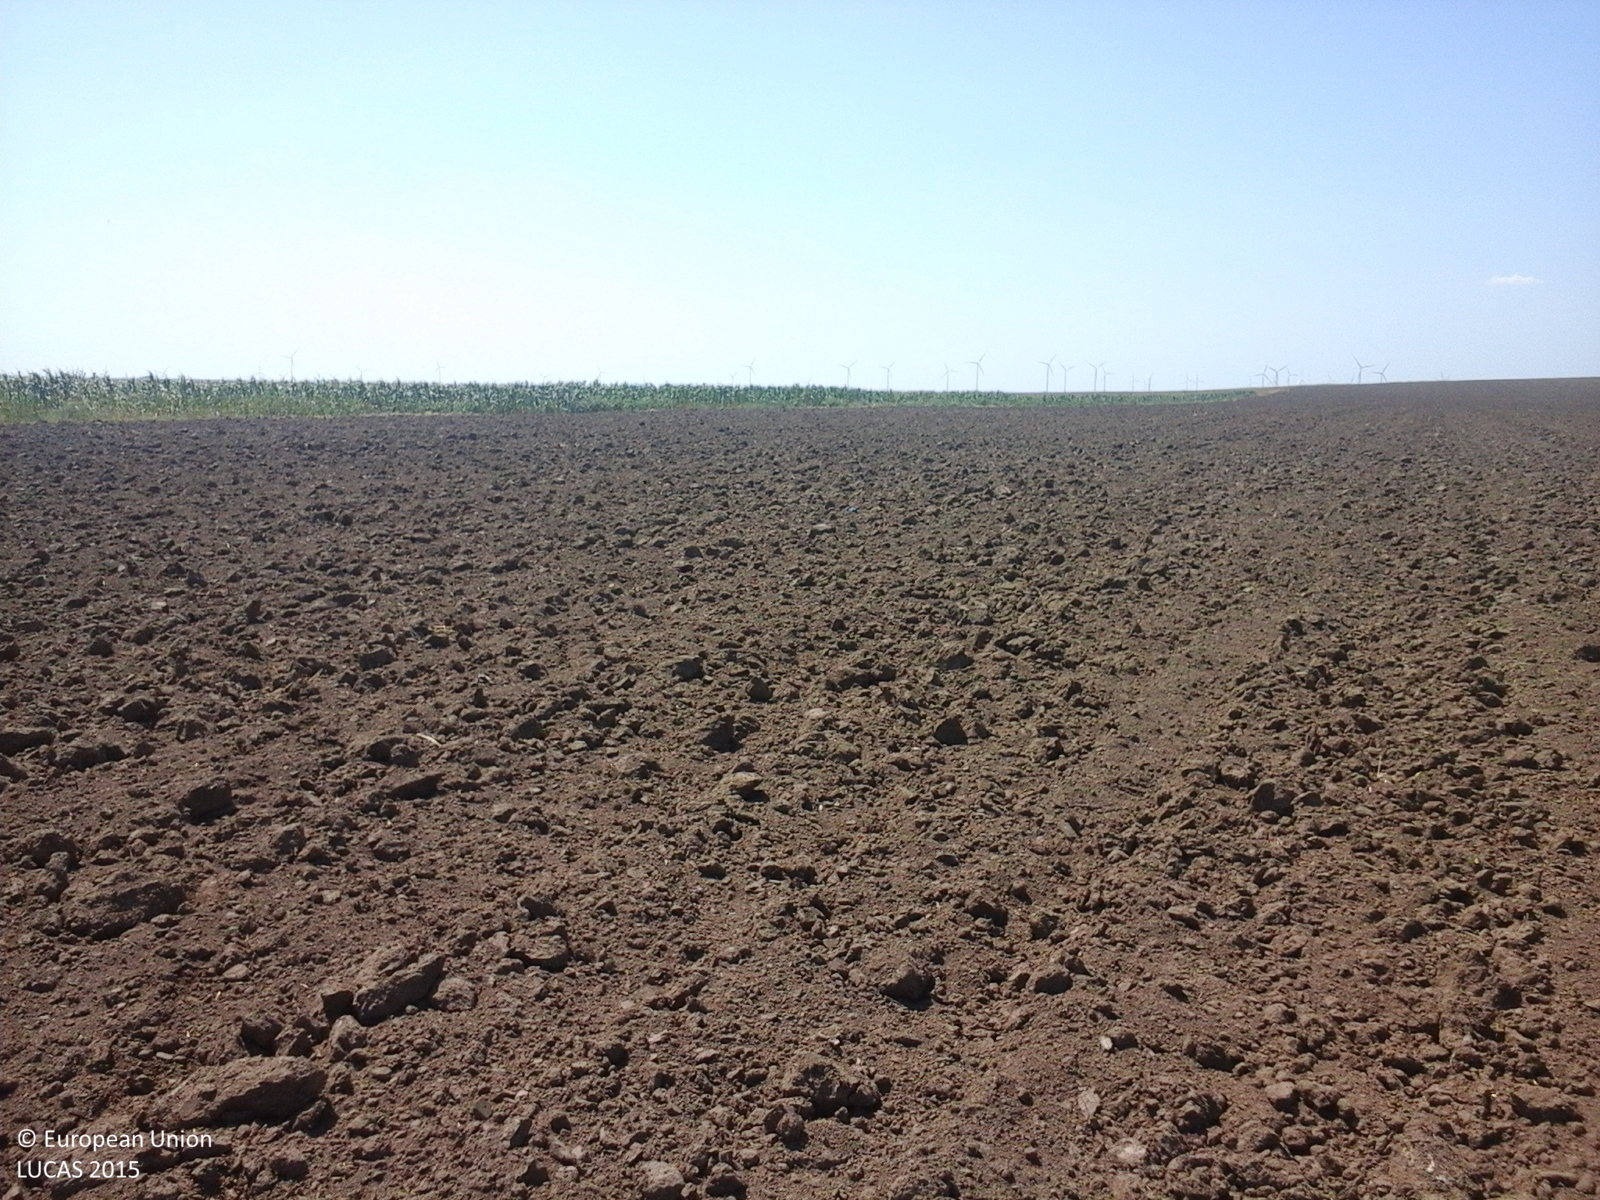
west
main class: Cropland
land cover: Durum wheat
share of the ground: < 10 %
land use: Agriculture (excluding fallow land and kitchen gardens)
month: August
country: RO
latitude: 44.4718
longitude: 28.4369
